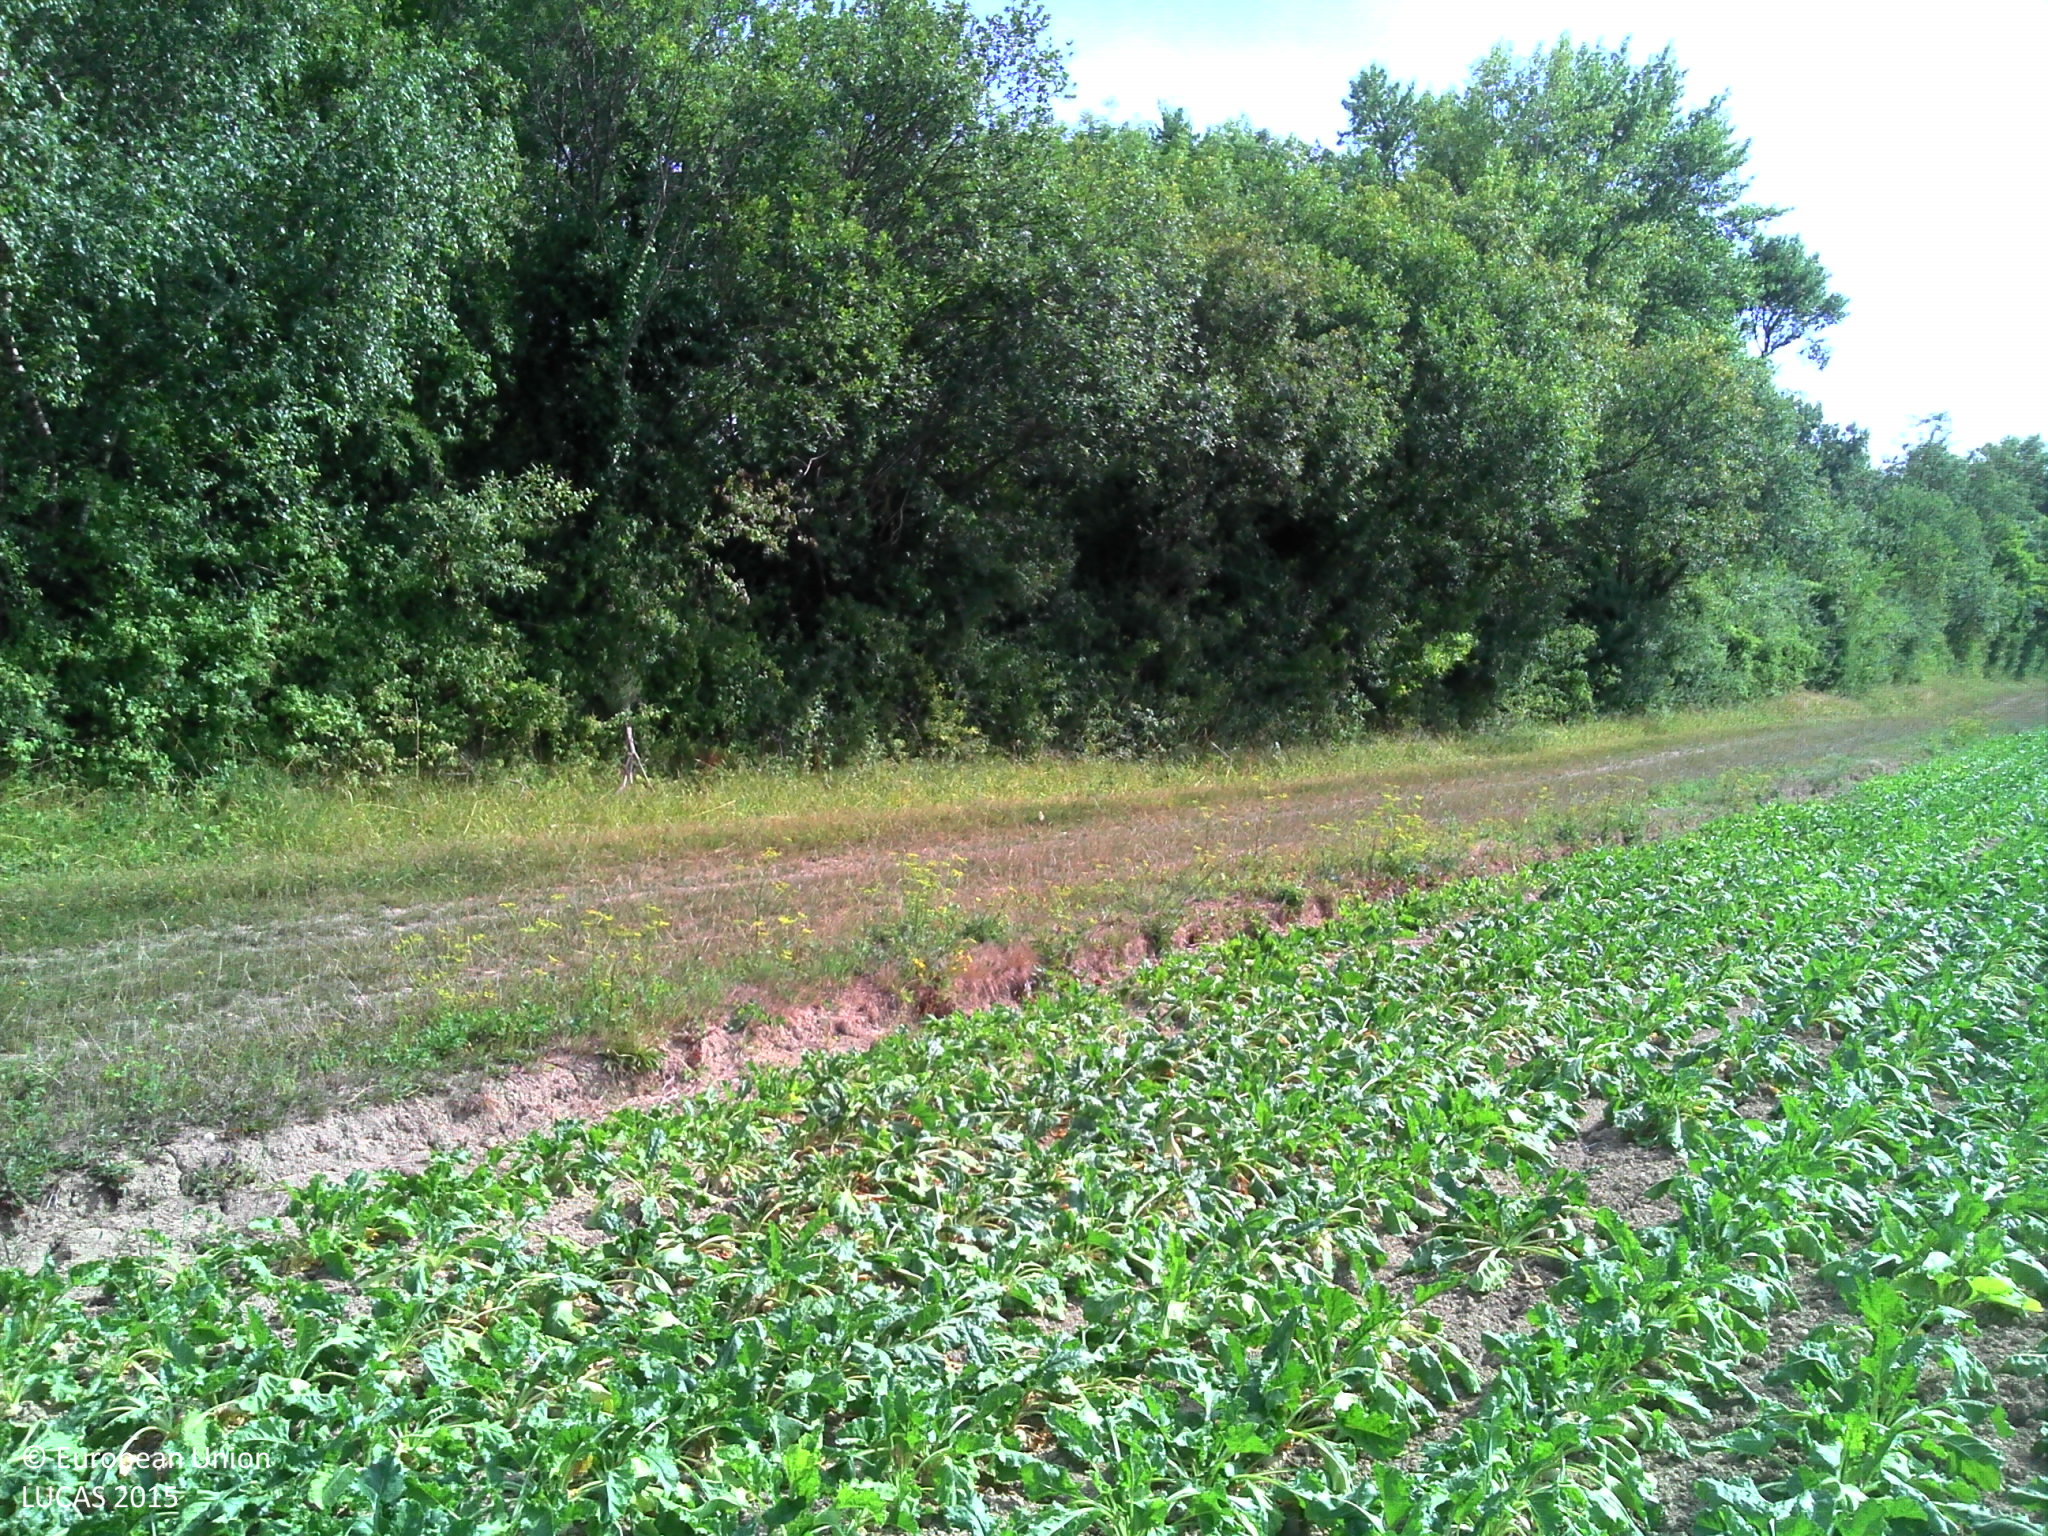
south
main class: Cropland
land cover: Sugar beet
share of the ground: > 75 %
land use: Agriculture (excluding fallow land and kitchen gardens)
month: July
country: FR
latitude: 48.5724
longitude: 3.8013
